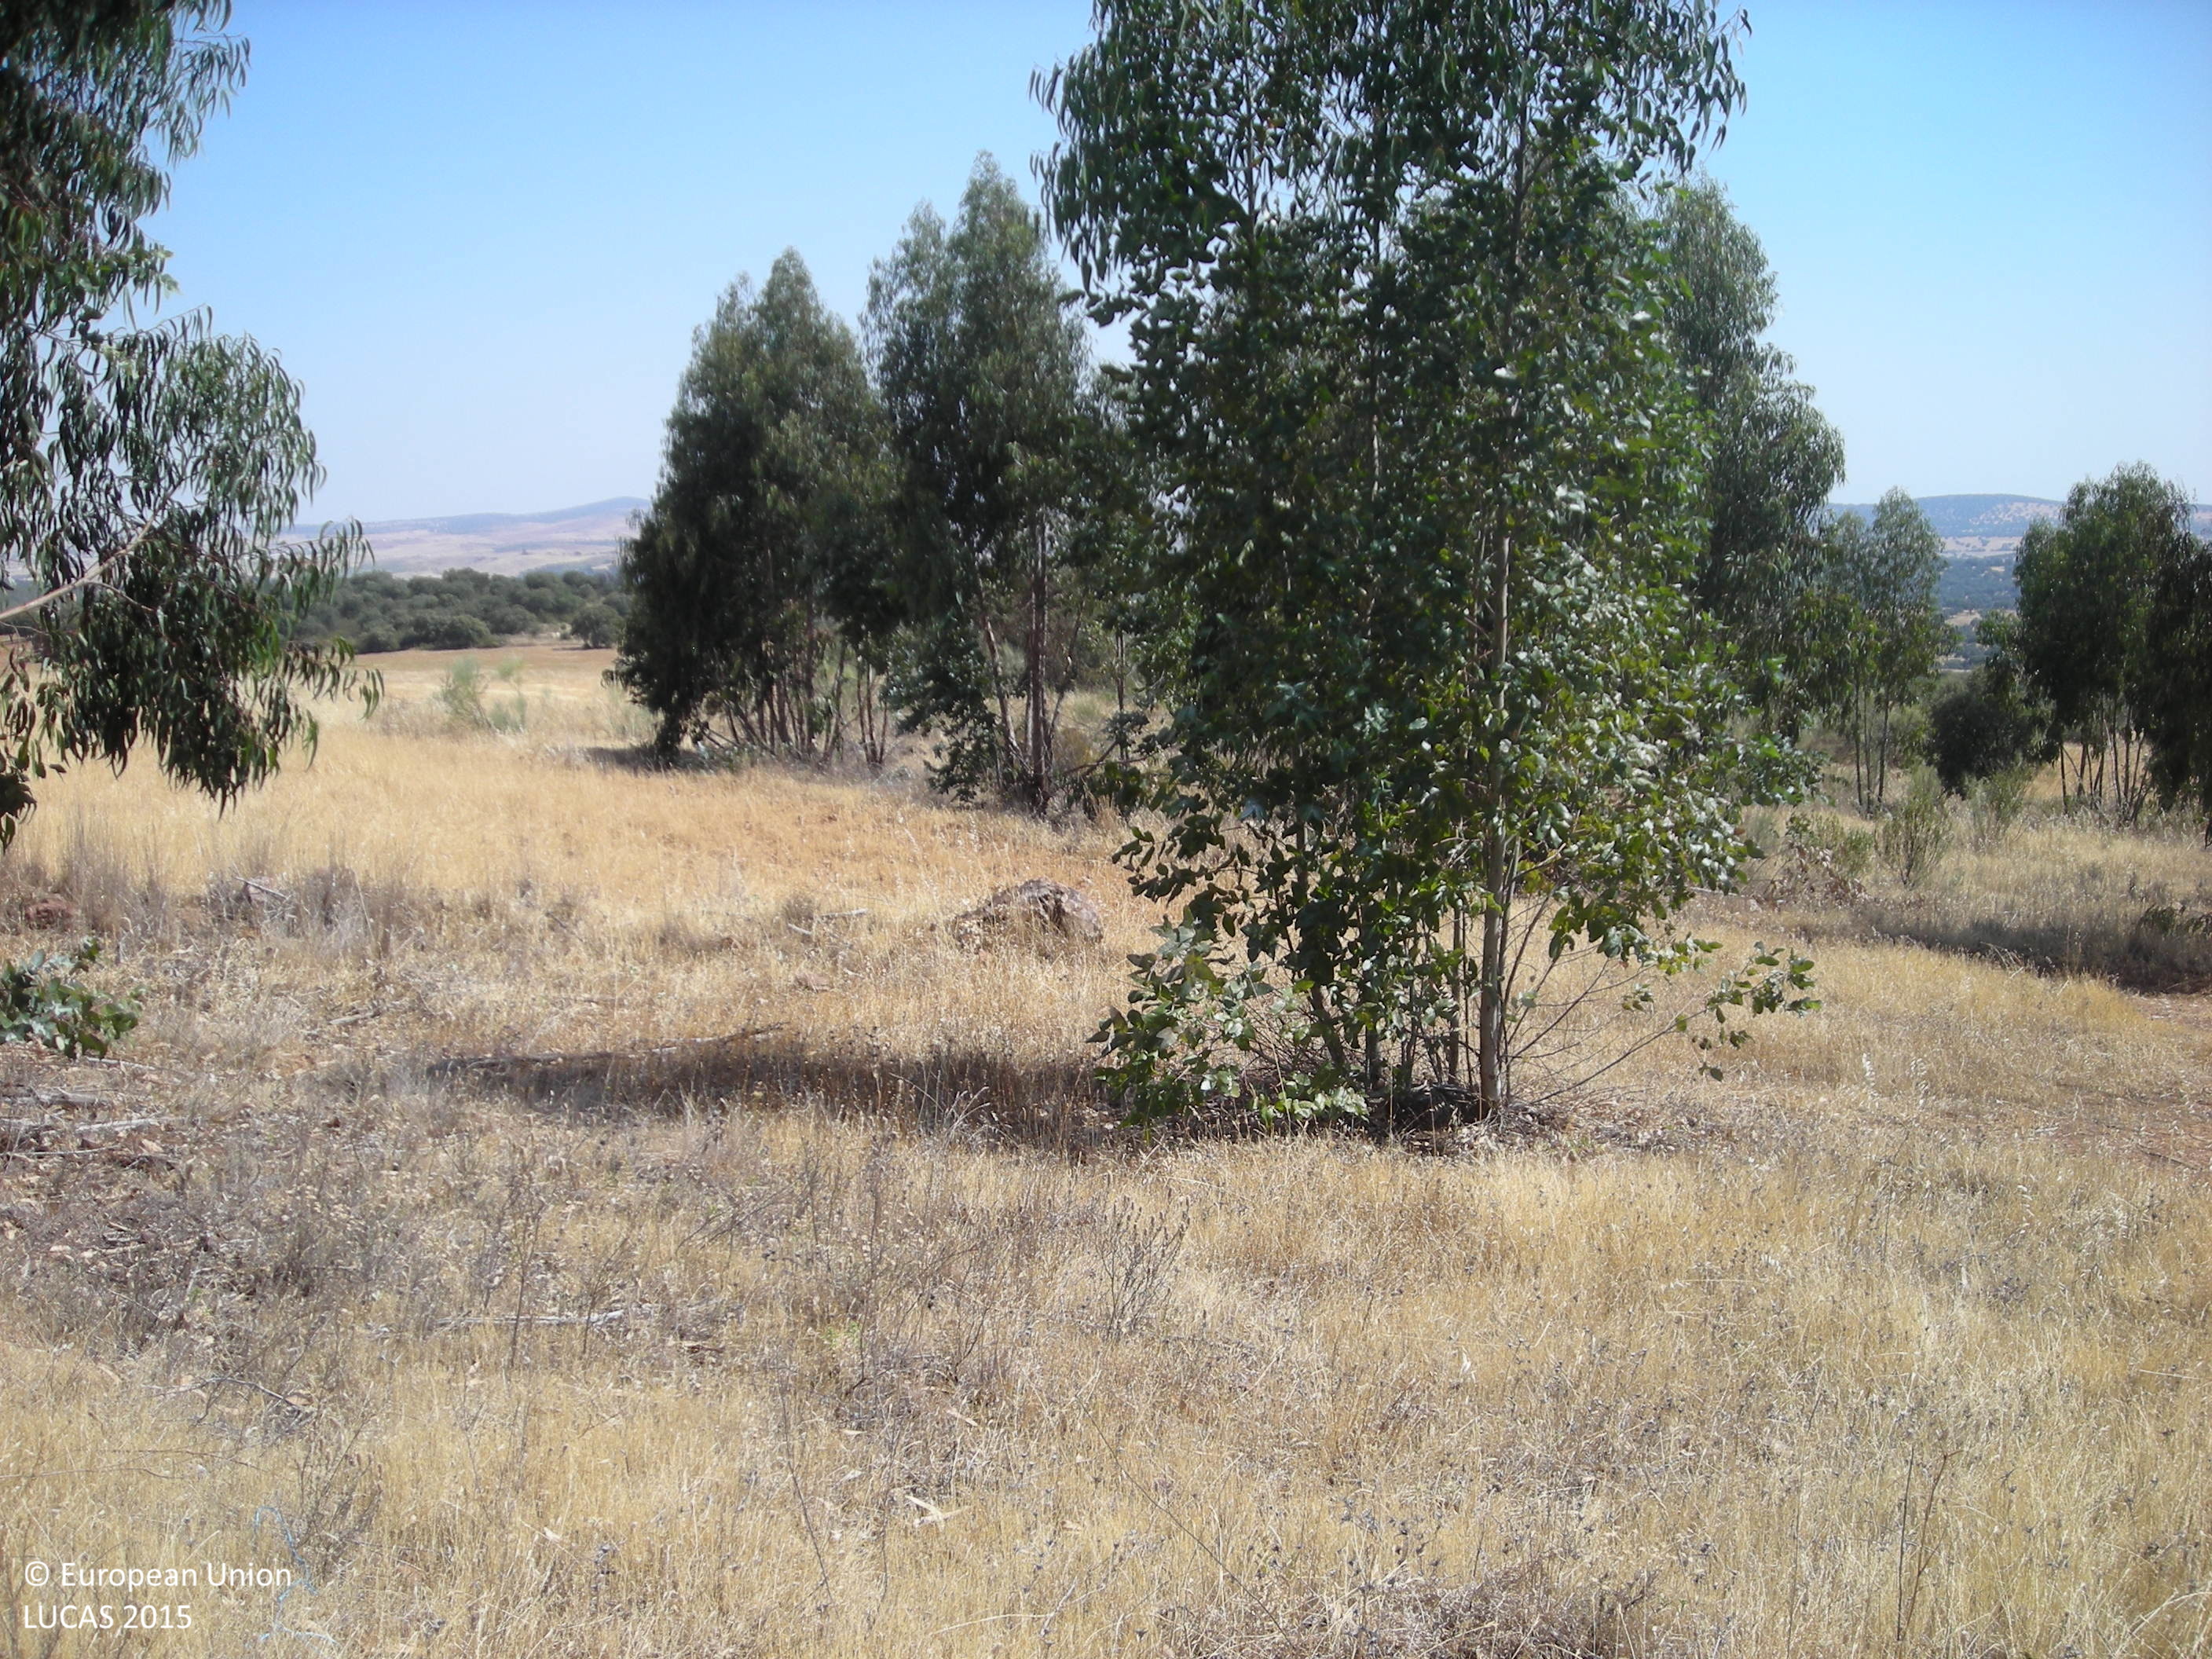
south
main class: Shrubland
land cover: Shrubland with sparse tree cover
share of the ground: > 75 %
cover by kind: shrubs 95 %, broadleaved forest trees 5 %
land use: Semi-natural and natural areas not in use
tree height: > 5 m
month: June
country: ES
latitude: 38.5794
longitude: -5.8726
